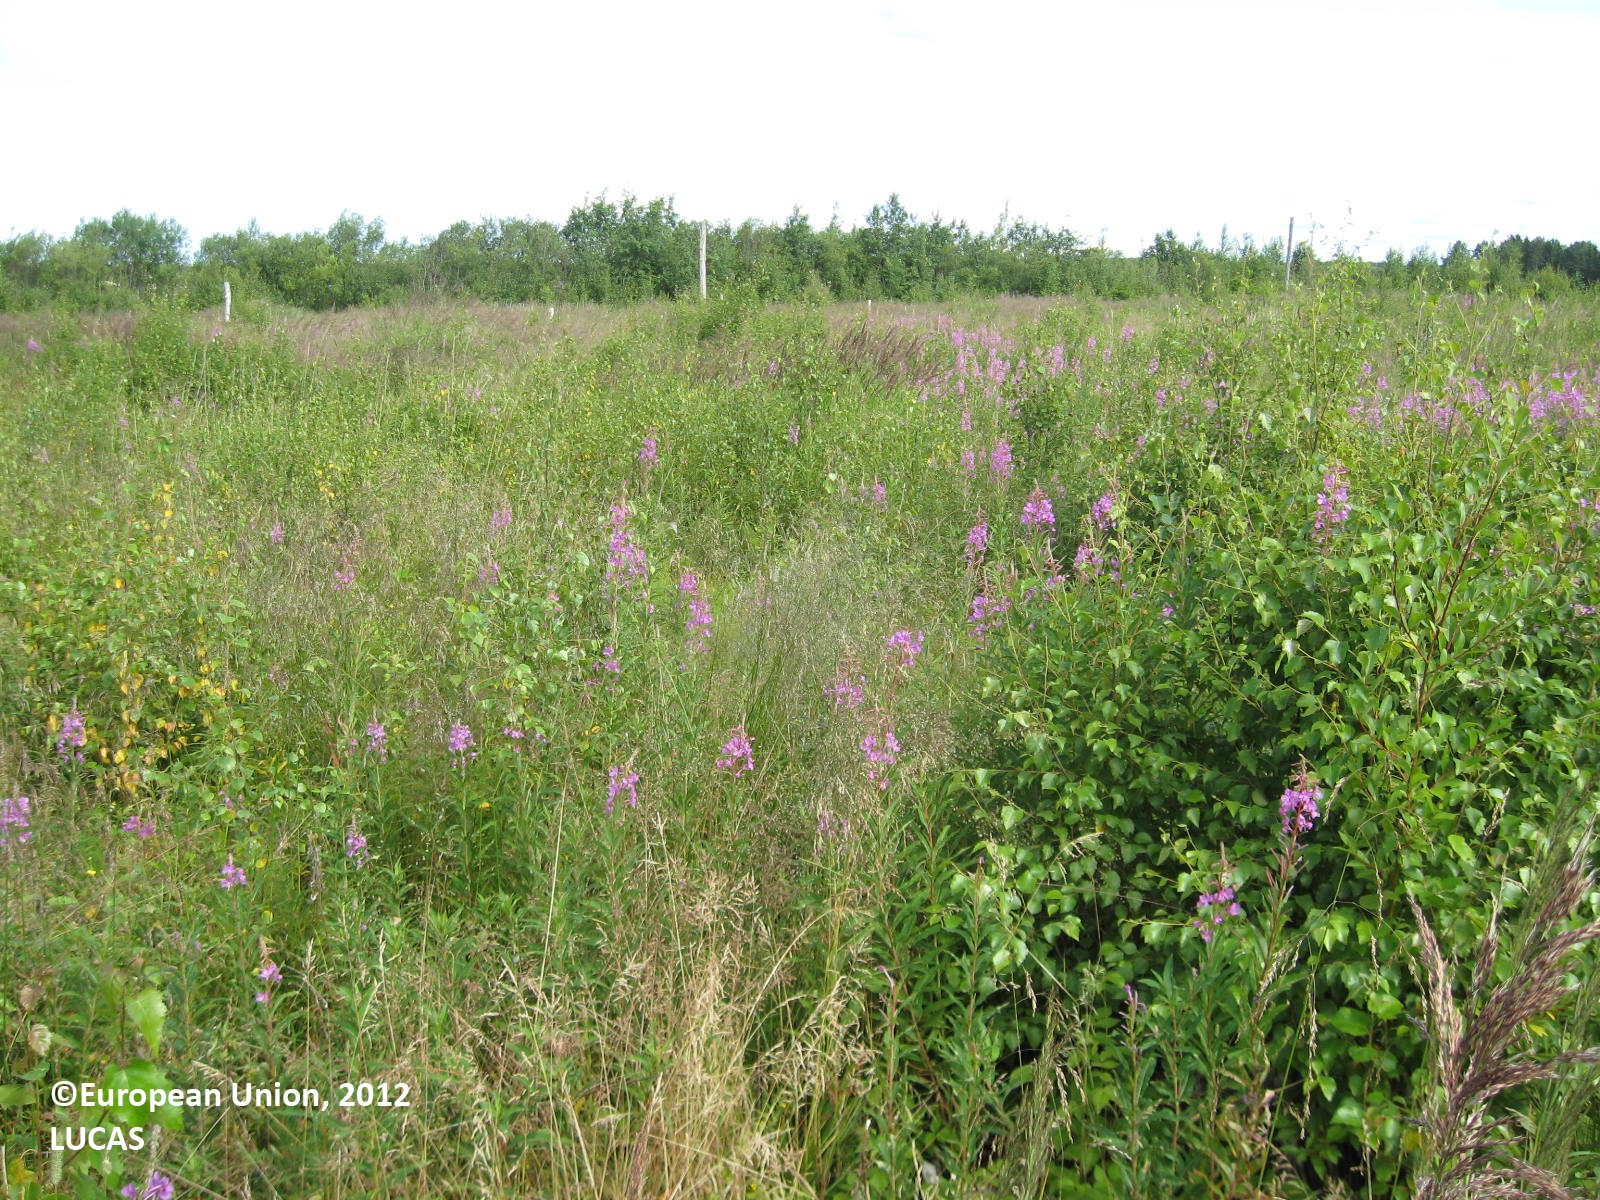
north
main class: Woodland
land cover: Broadleaved woodland
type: boreal forest
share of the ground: 10 - 25 %
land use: Forestry
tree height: < 5 m
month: July
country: FI
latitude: 62.2996
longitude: 21.4796
